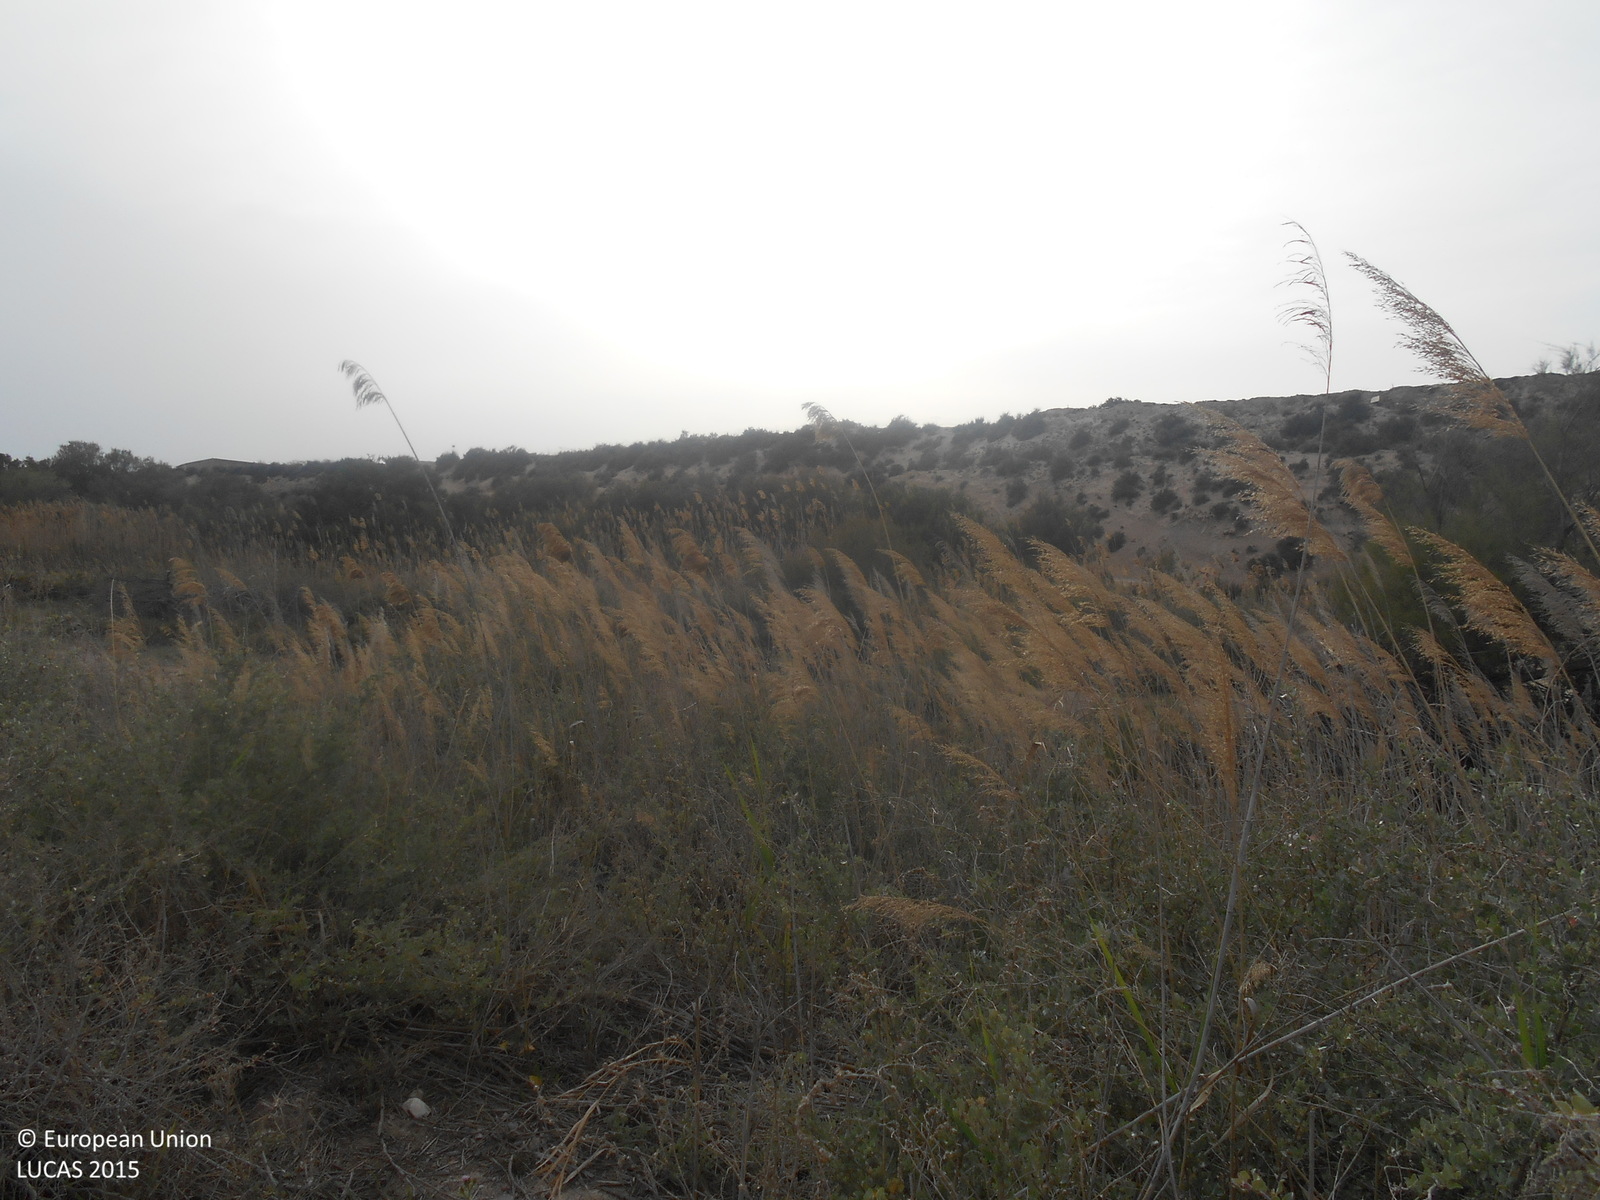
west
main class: Shrubland
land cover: Shrubland without tree cover
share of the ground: 25 - 50 %
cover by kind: shrubs 40 %, unconsolidated bare surface 40 %, herbaceous plants 20 %
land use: Semi-natural and natural areas not in use
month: April
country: ES
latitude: 37.7535
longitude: -1.4117
